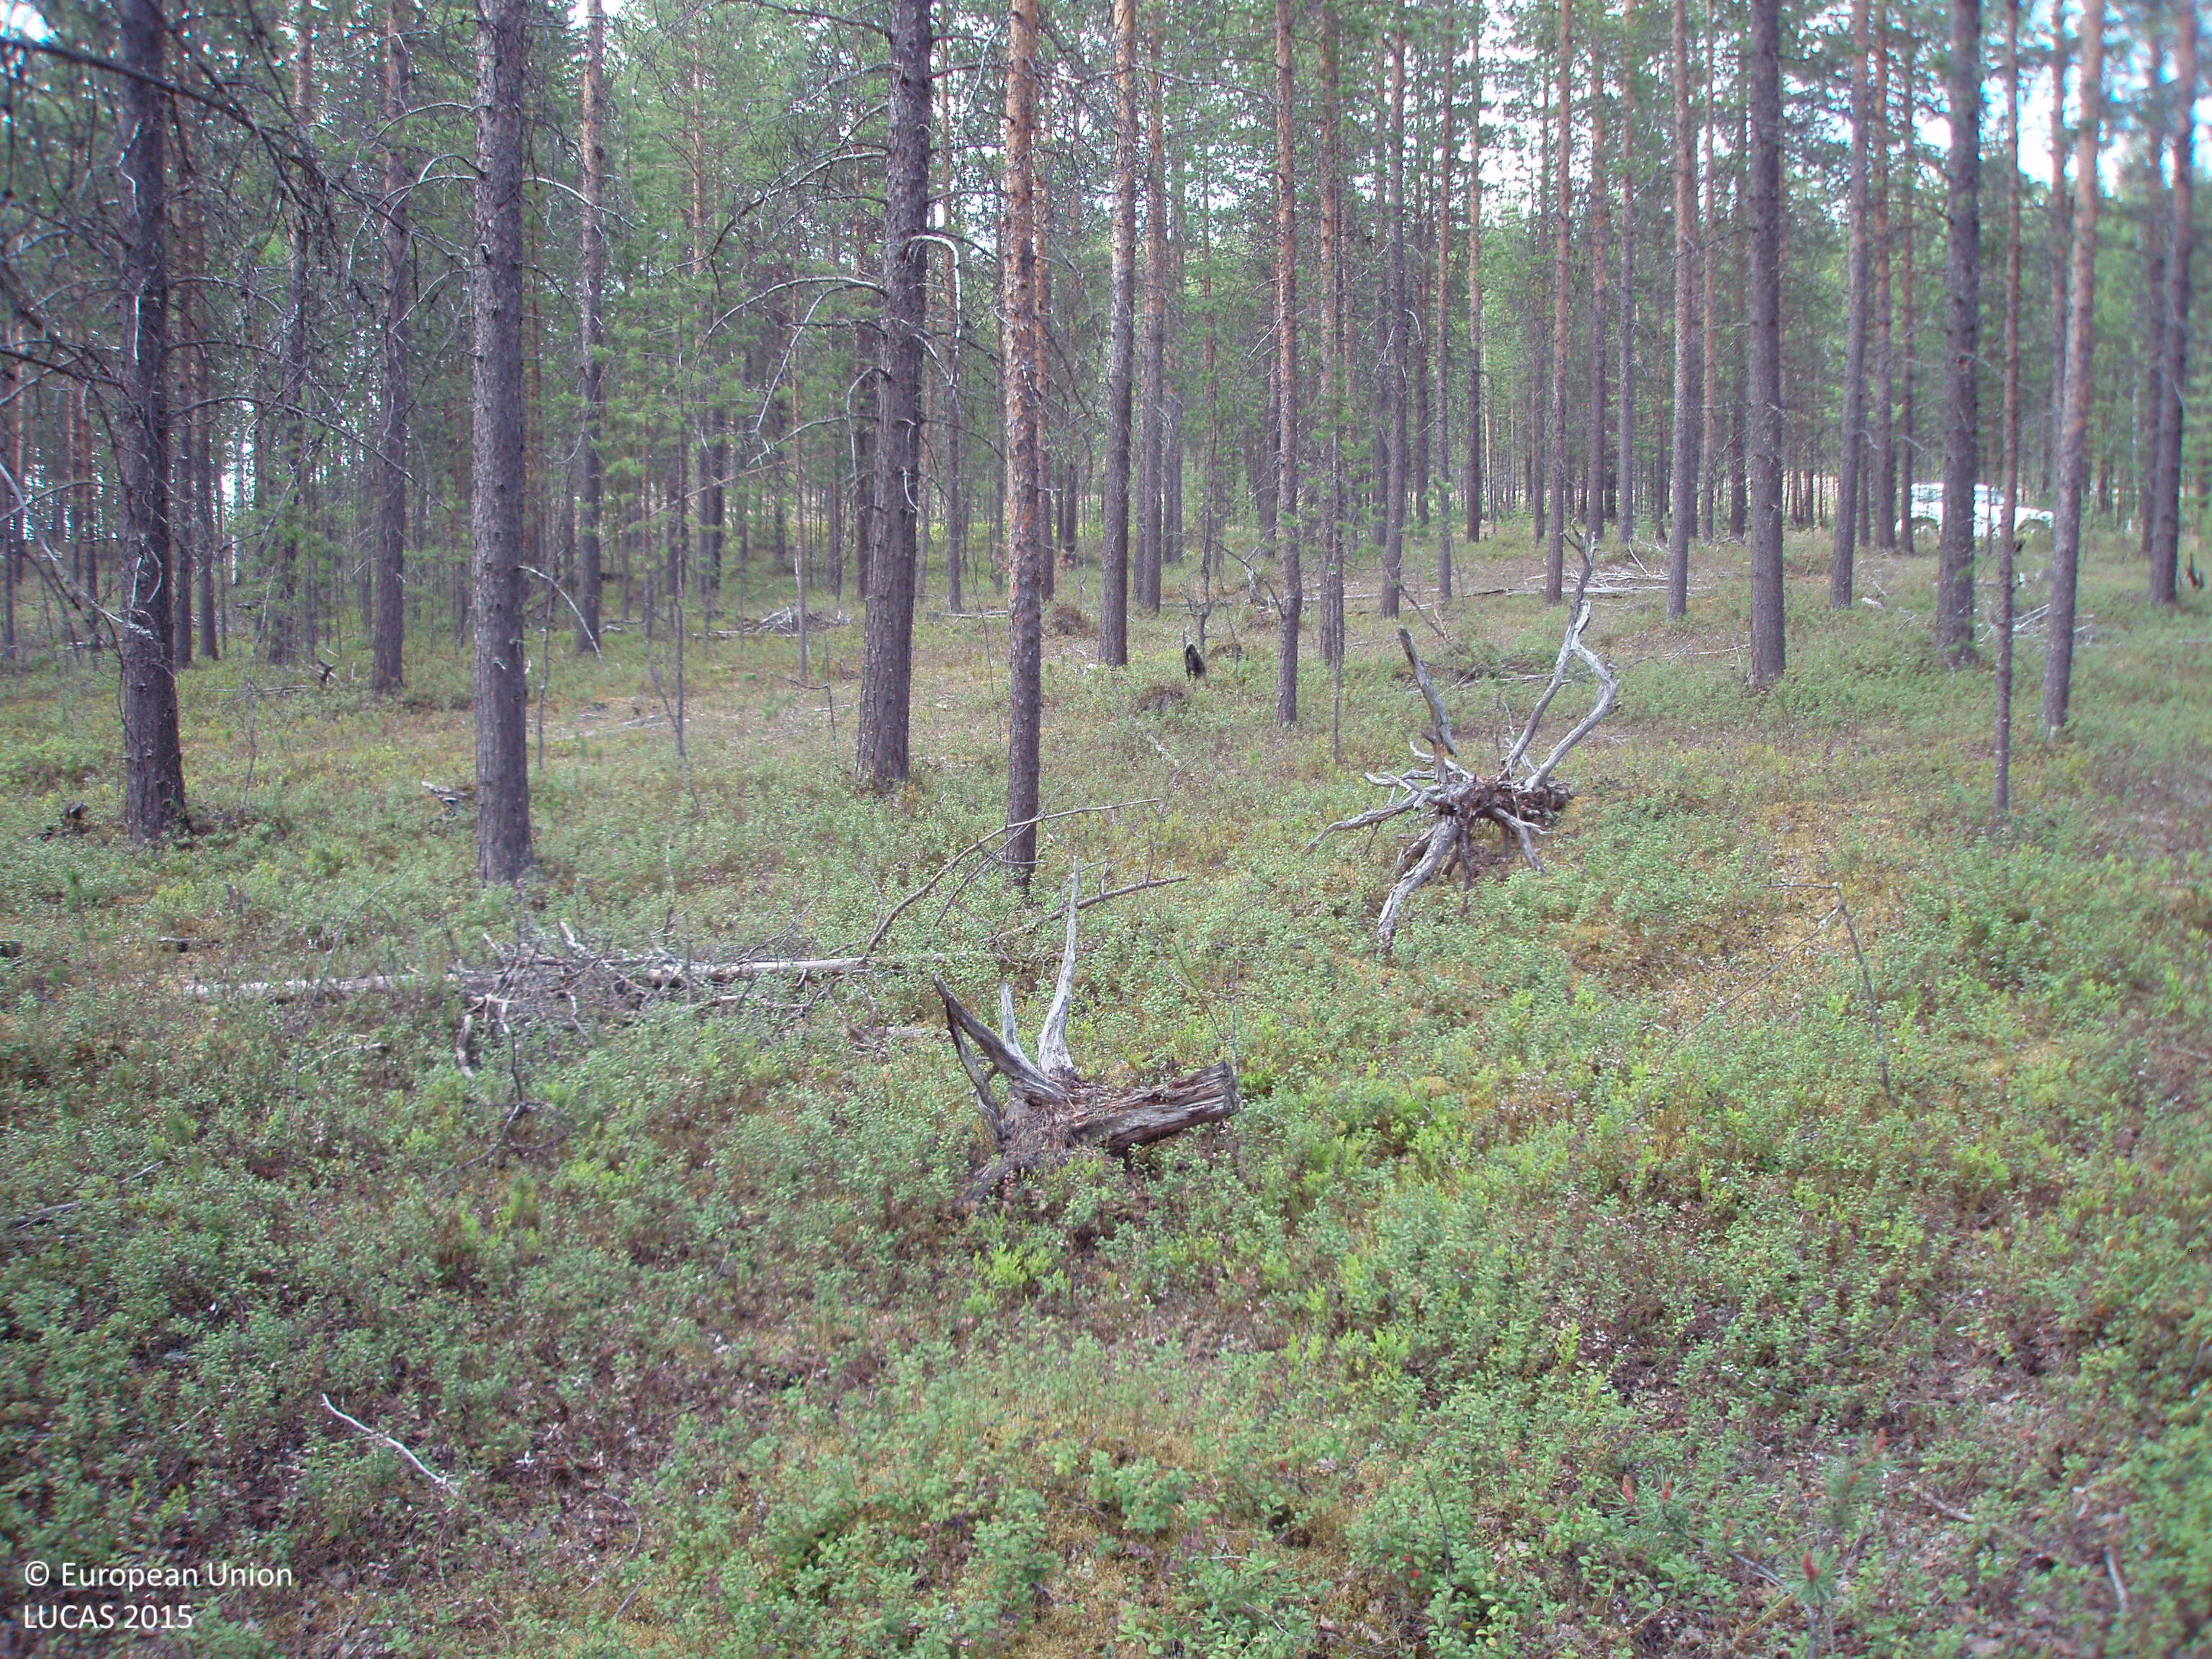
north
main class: Woodland
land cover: Pine dominated coniferous woodland
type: boreal forest
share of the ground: 50 - 75 %
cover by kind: coniferous forest trees 65 %, shrubs 25 %, broadleaved forest trees 5 %, lichens and mosses 5 %
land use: Forestry
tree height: > 5 m
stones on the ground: < 10 %
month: June
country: FI
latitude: 68.5085
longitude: 28.0734
